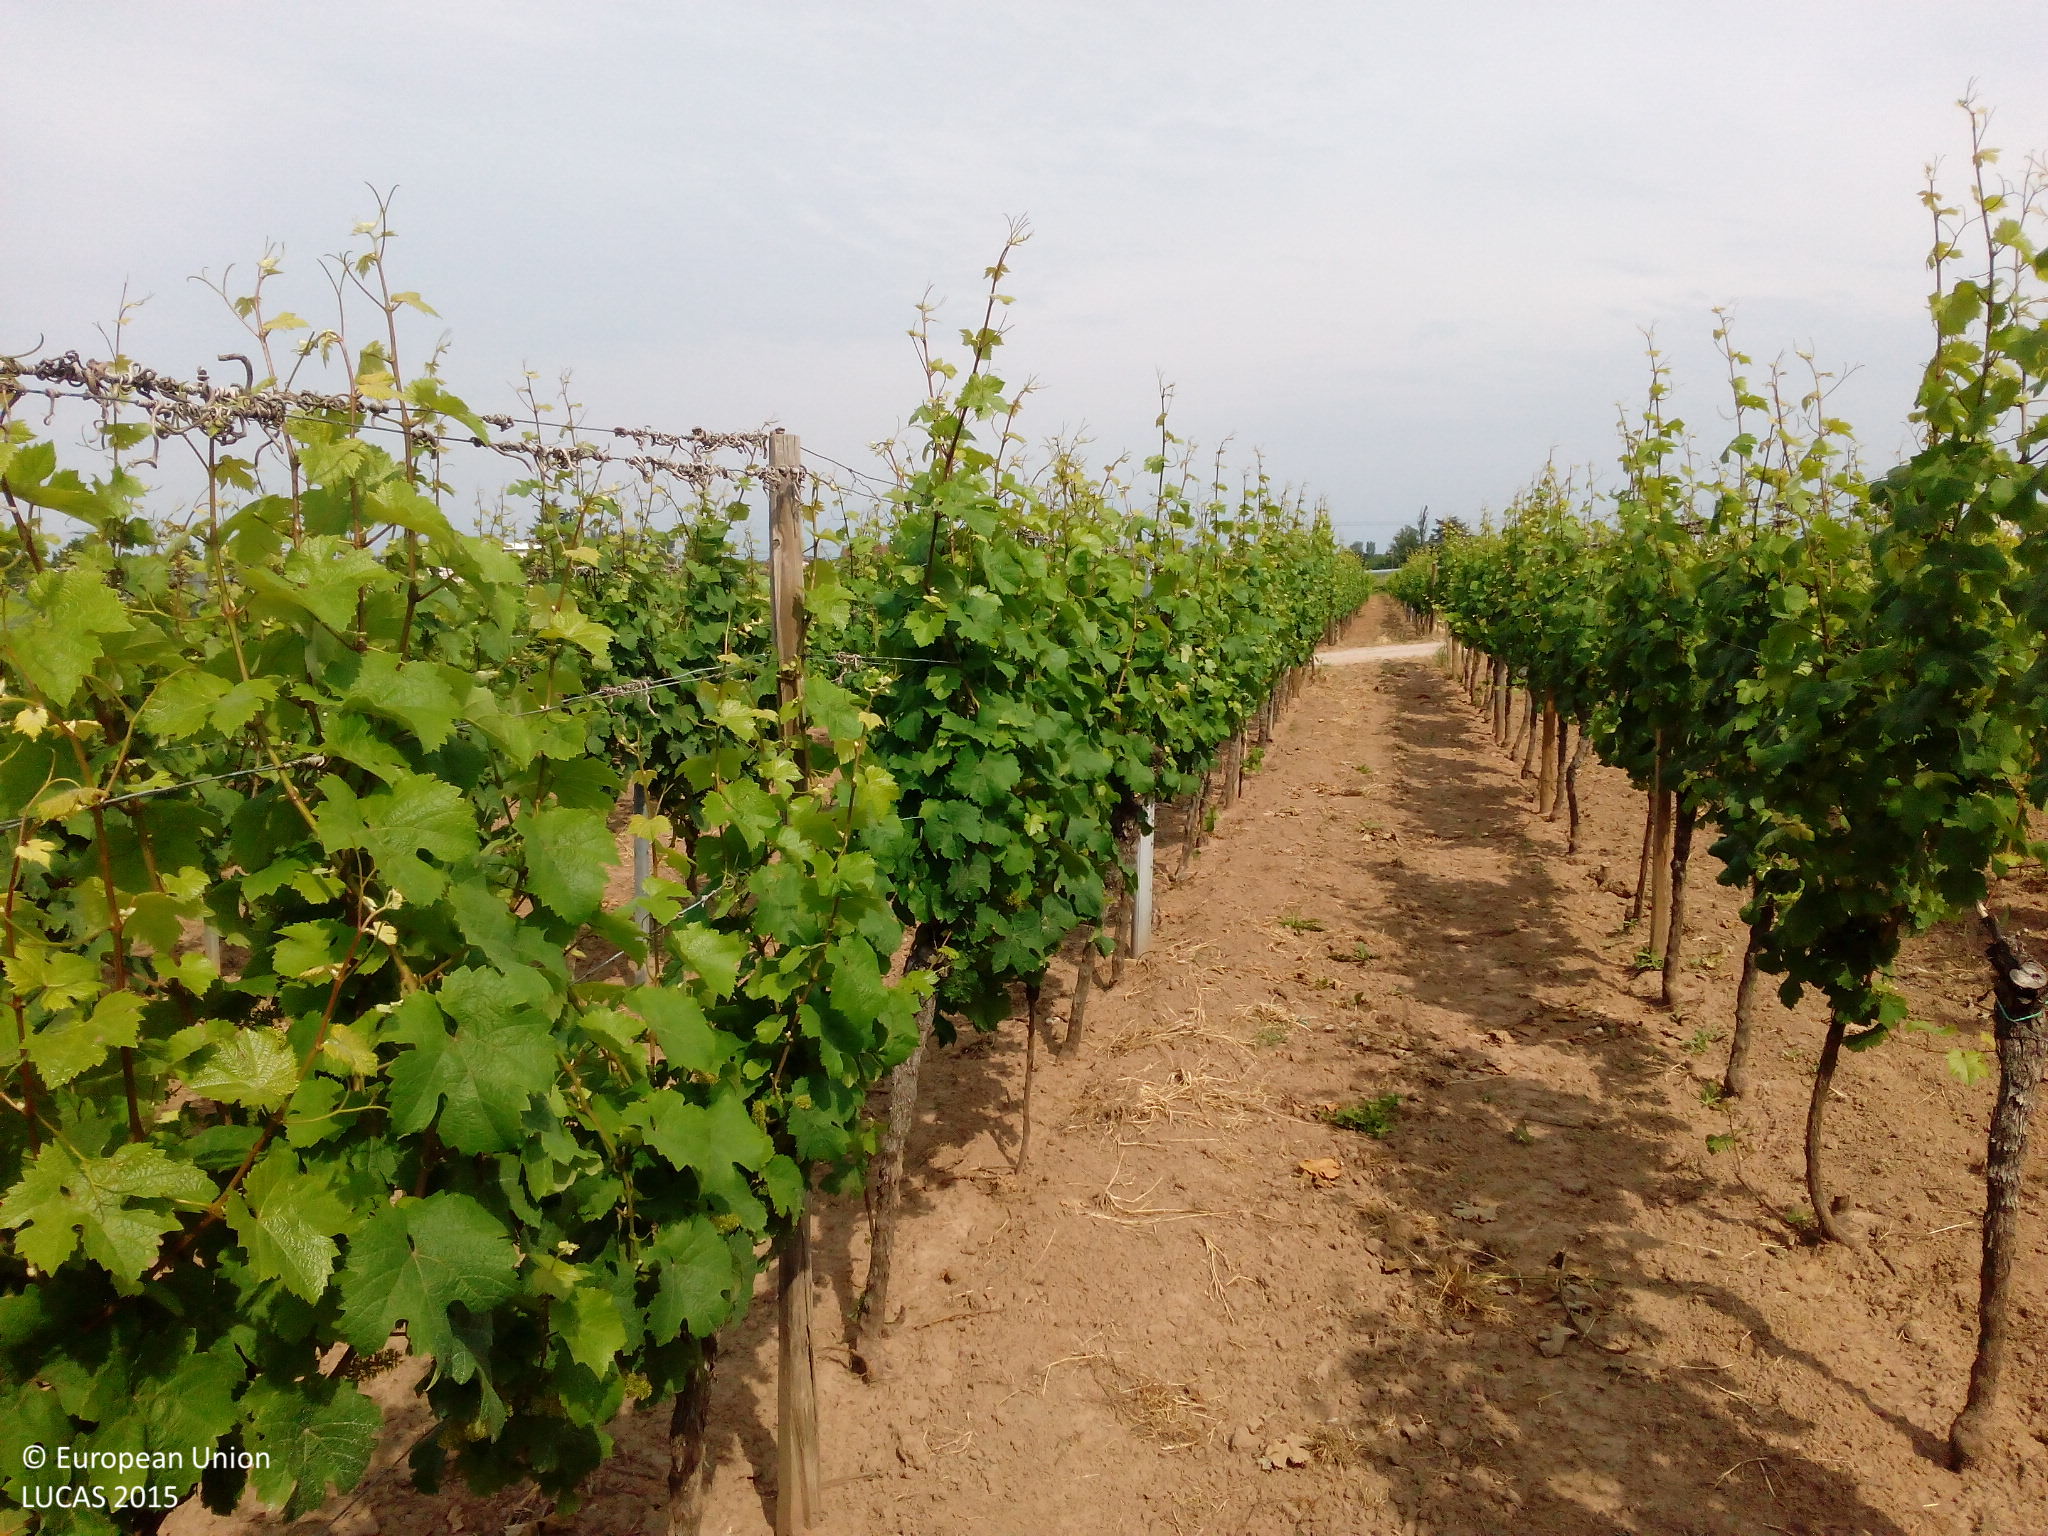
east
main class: Cropland
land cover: Vineyards
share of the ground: < 10 %
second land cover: Other bare soil
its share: > 75 %
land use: Agriculture (excluding fallow land and kitchen gardens)
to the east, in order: Vineyards; Other bare soil; Tracks; Vineyards; Grassland without tree/shrub cover; Vineyards; Spontaneously vegetated surfaces
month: June
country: DE
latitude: 49.3421
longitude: 8.1700
